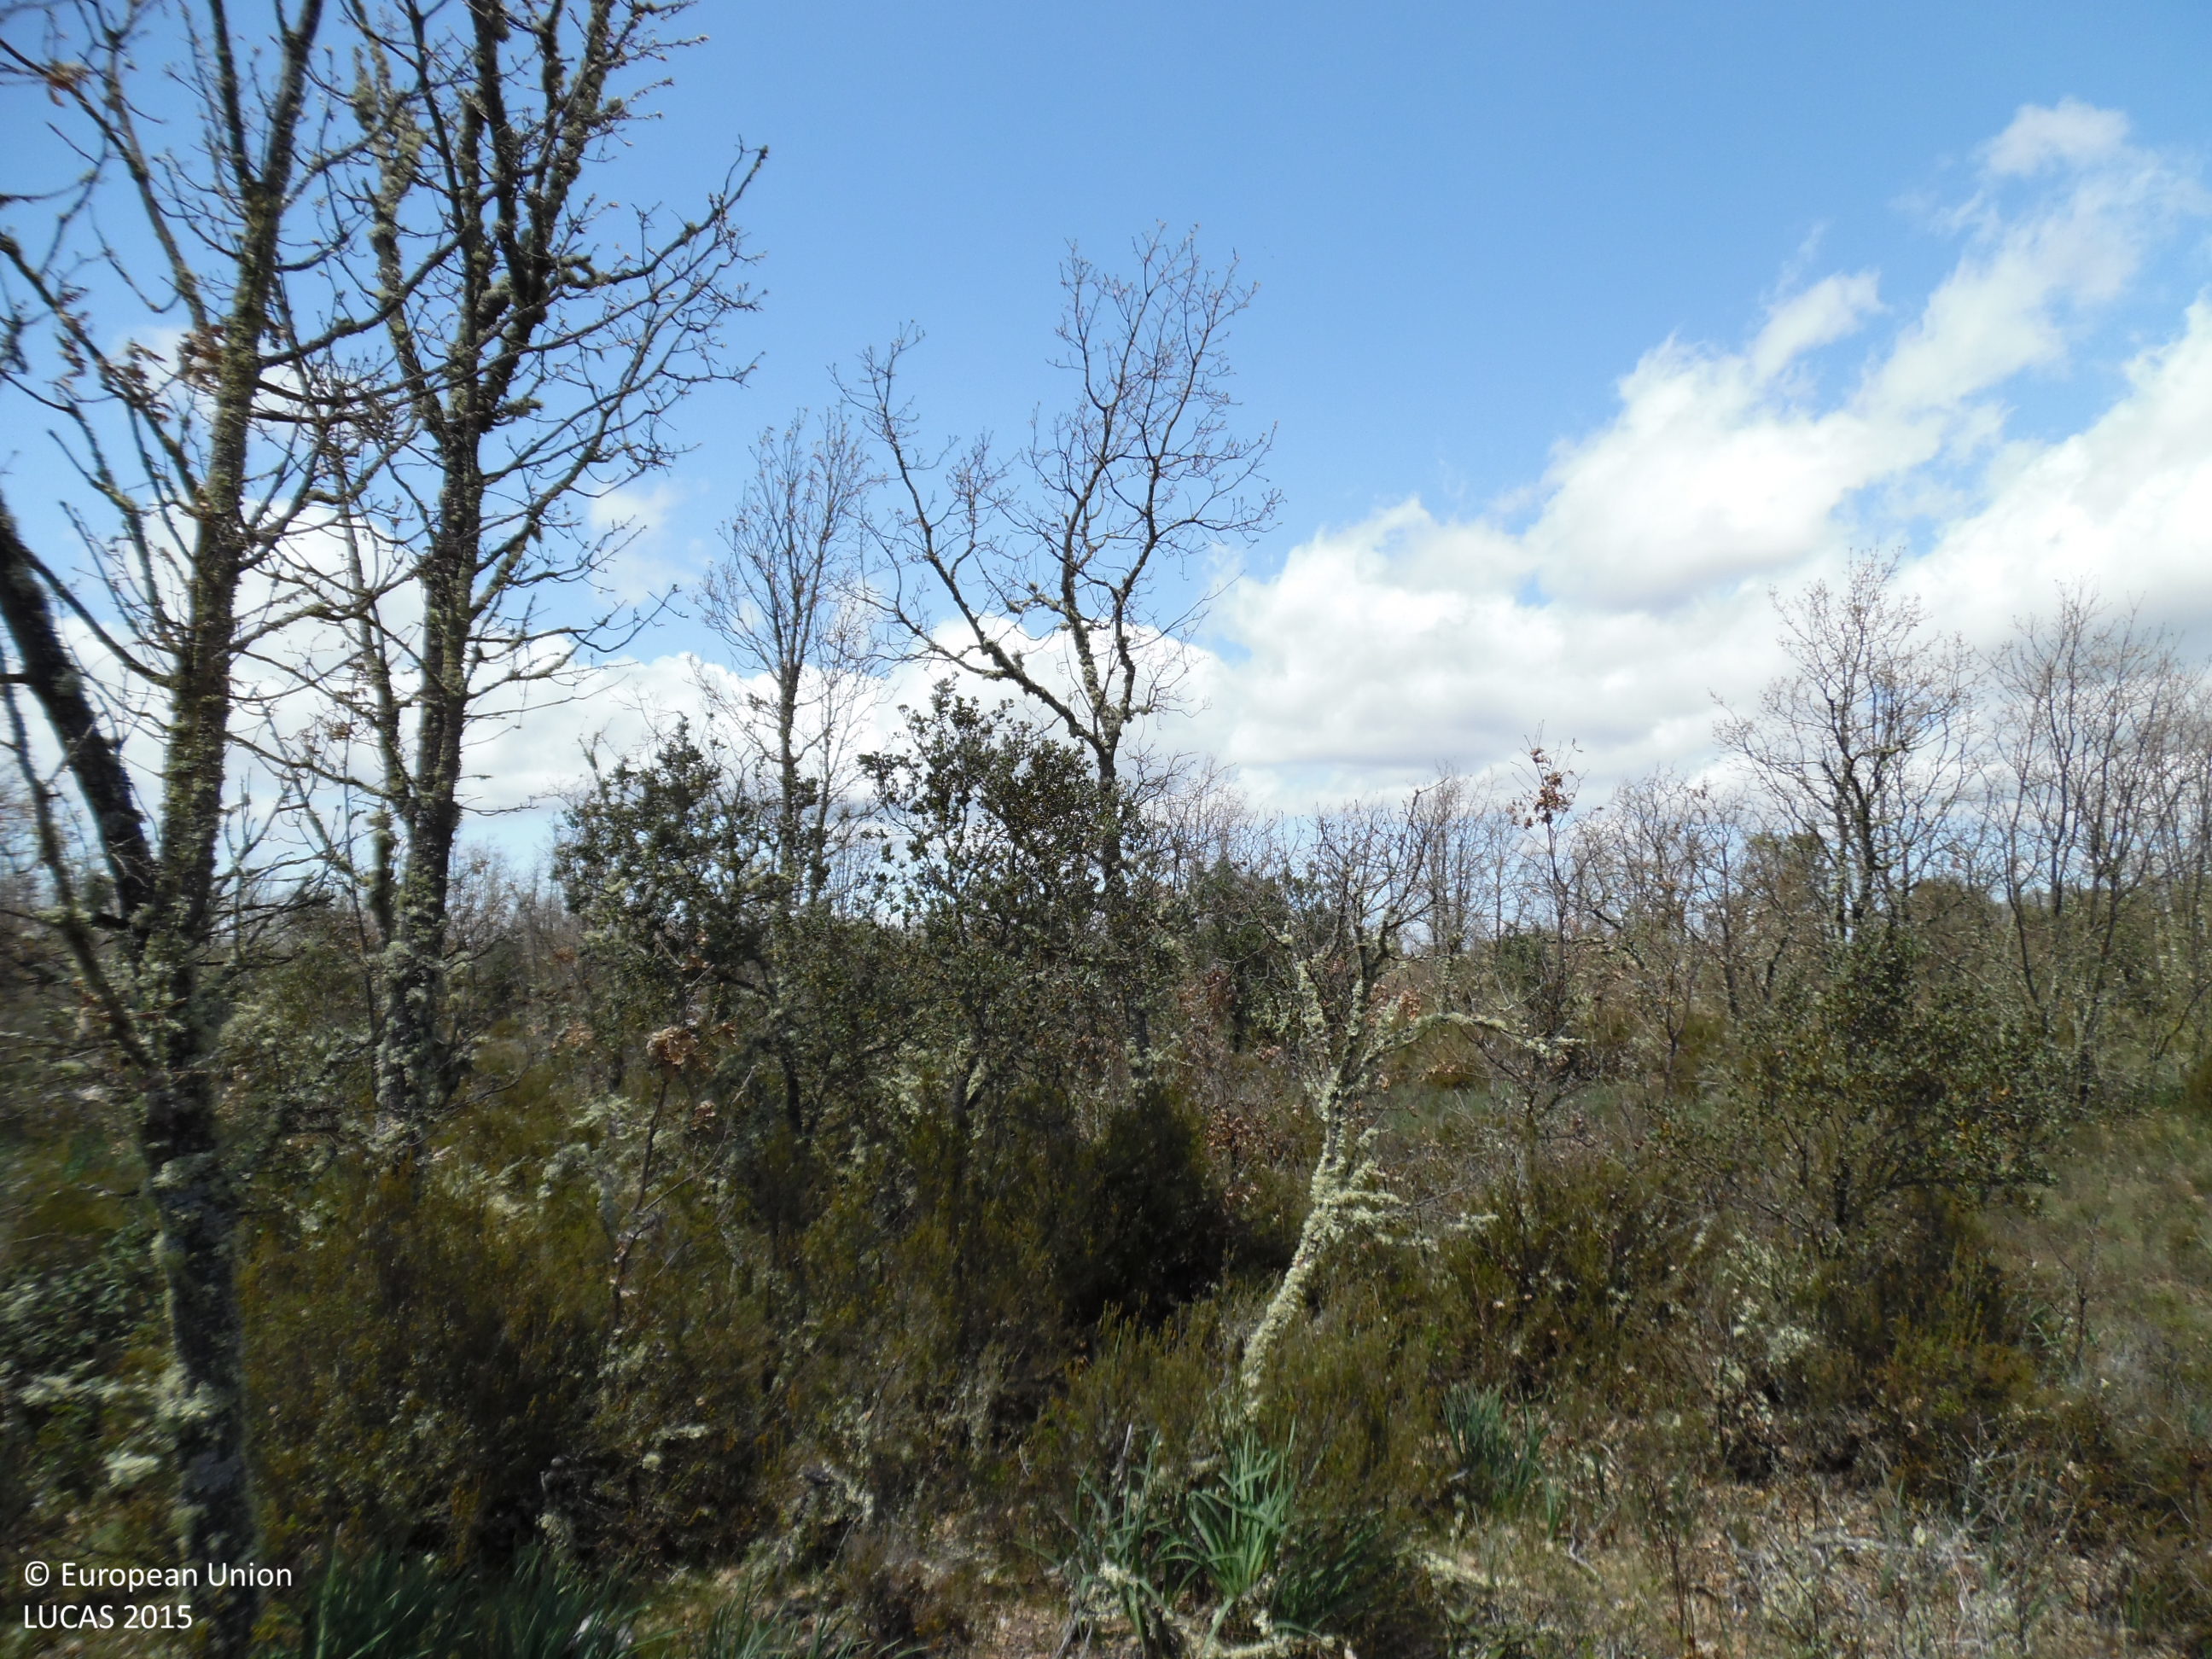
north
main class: Shrubland
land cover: Shrubland with sparse tree cover
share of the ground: > 75 %
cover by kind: shrubs 95 %, broadleaved forest trees 5 %
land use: Forestry
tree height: > 5 m
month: May
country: ES
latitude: 42.2870
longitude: -6.0263
